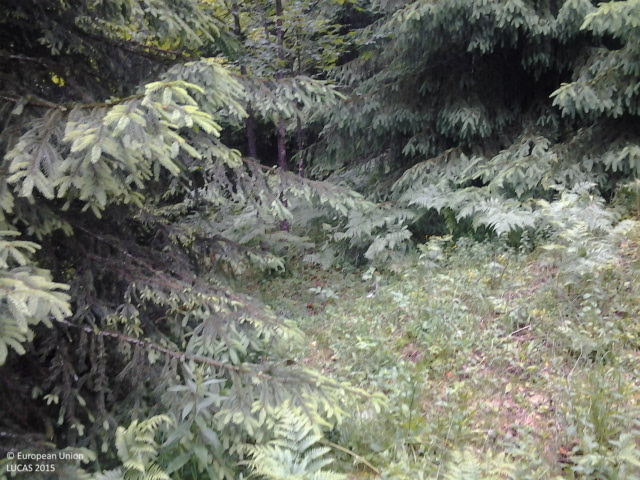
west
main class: Woodland
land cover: Spruce dominated mixed woodland
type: alpine coniferous forest
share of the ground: > 75 %
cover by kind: coniferous forest trees 70 %, broadleaved forest trees 30 %
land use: Forestry
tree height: > 5 m
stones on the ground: 25 - 50 %
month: June
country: RO
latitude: 47.2581
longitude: 25.2933
